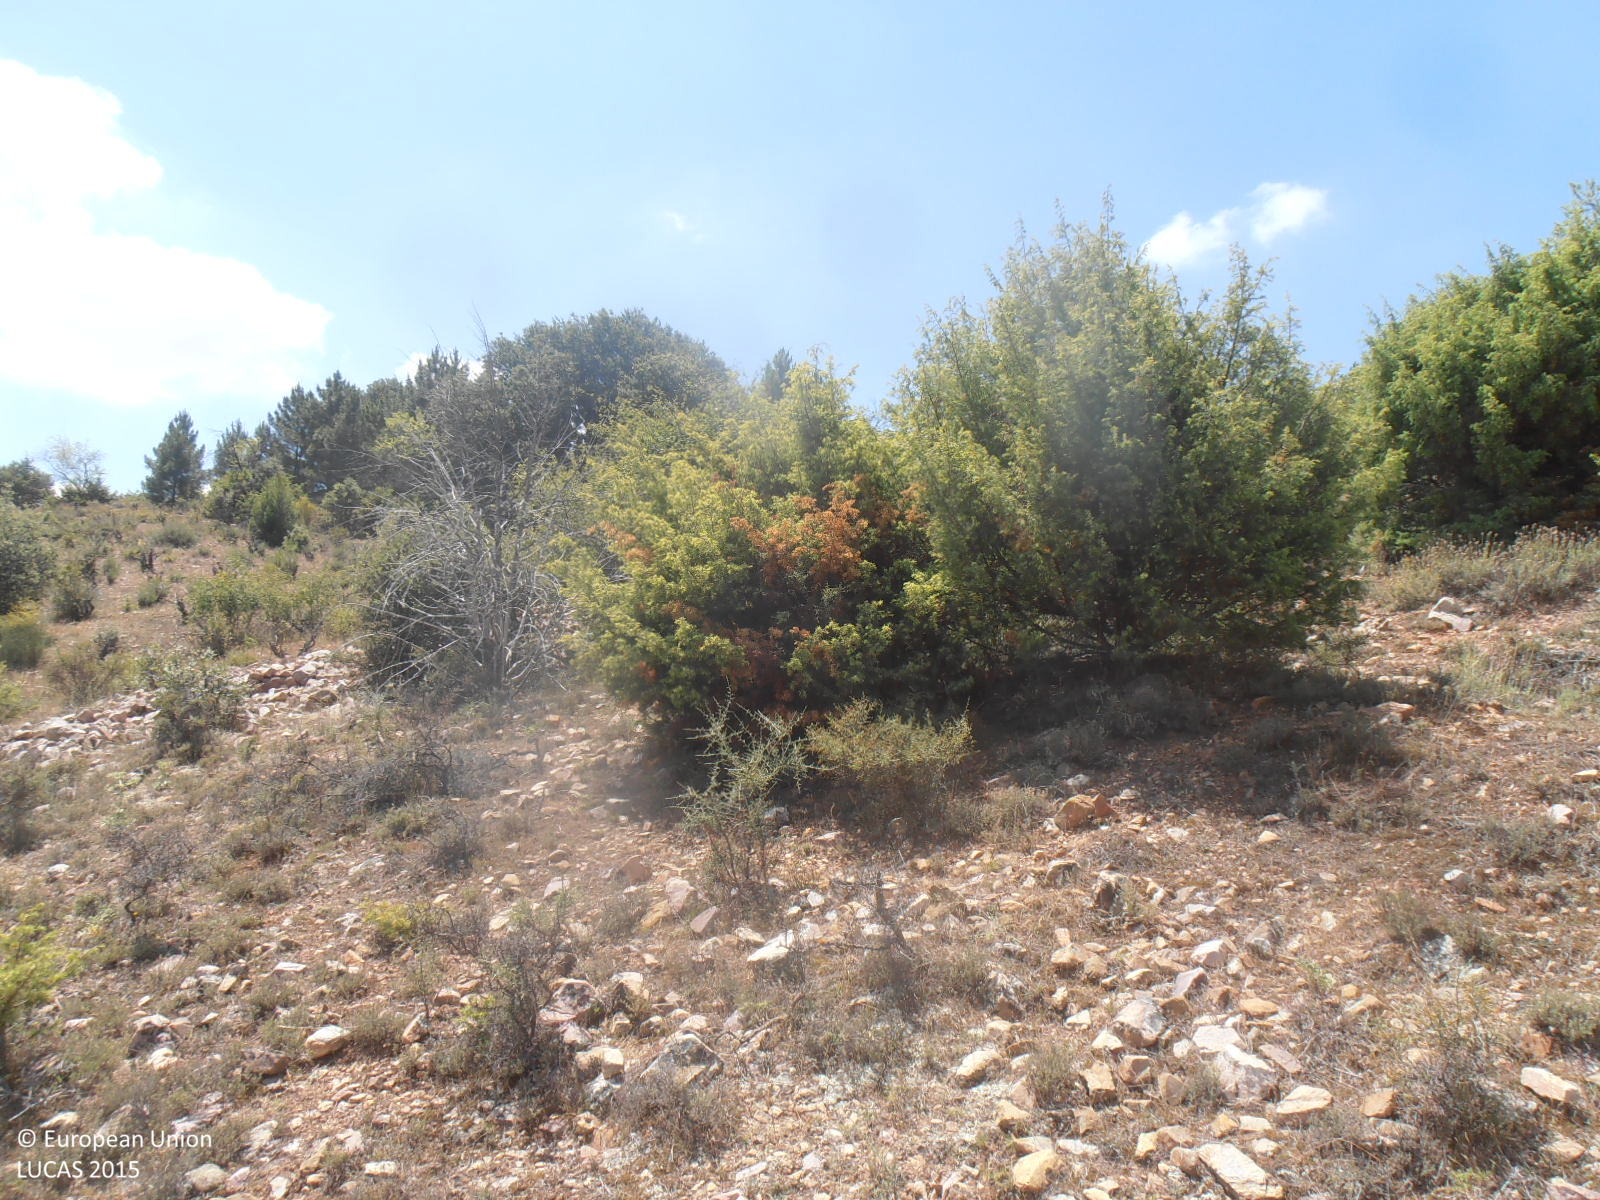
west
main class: Shrubland
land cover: Shrubland with sparse tree cover
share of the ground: 50 - 75 %
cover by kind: shrubs 60 %, consolidated bare surface 20 %, herbaceous plants 15 %, coniferous forest trees 5 %
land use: Semi-natural and natural areas not in use
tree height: < 5 m
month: June
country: ES
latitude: 41.2791
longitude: -1.4003
